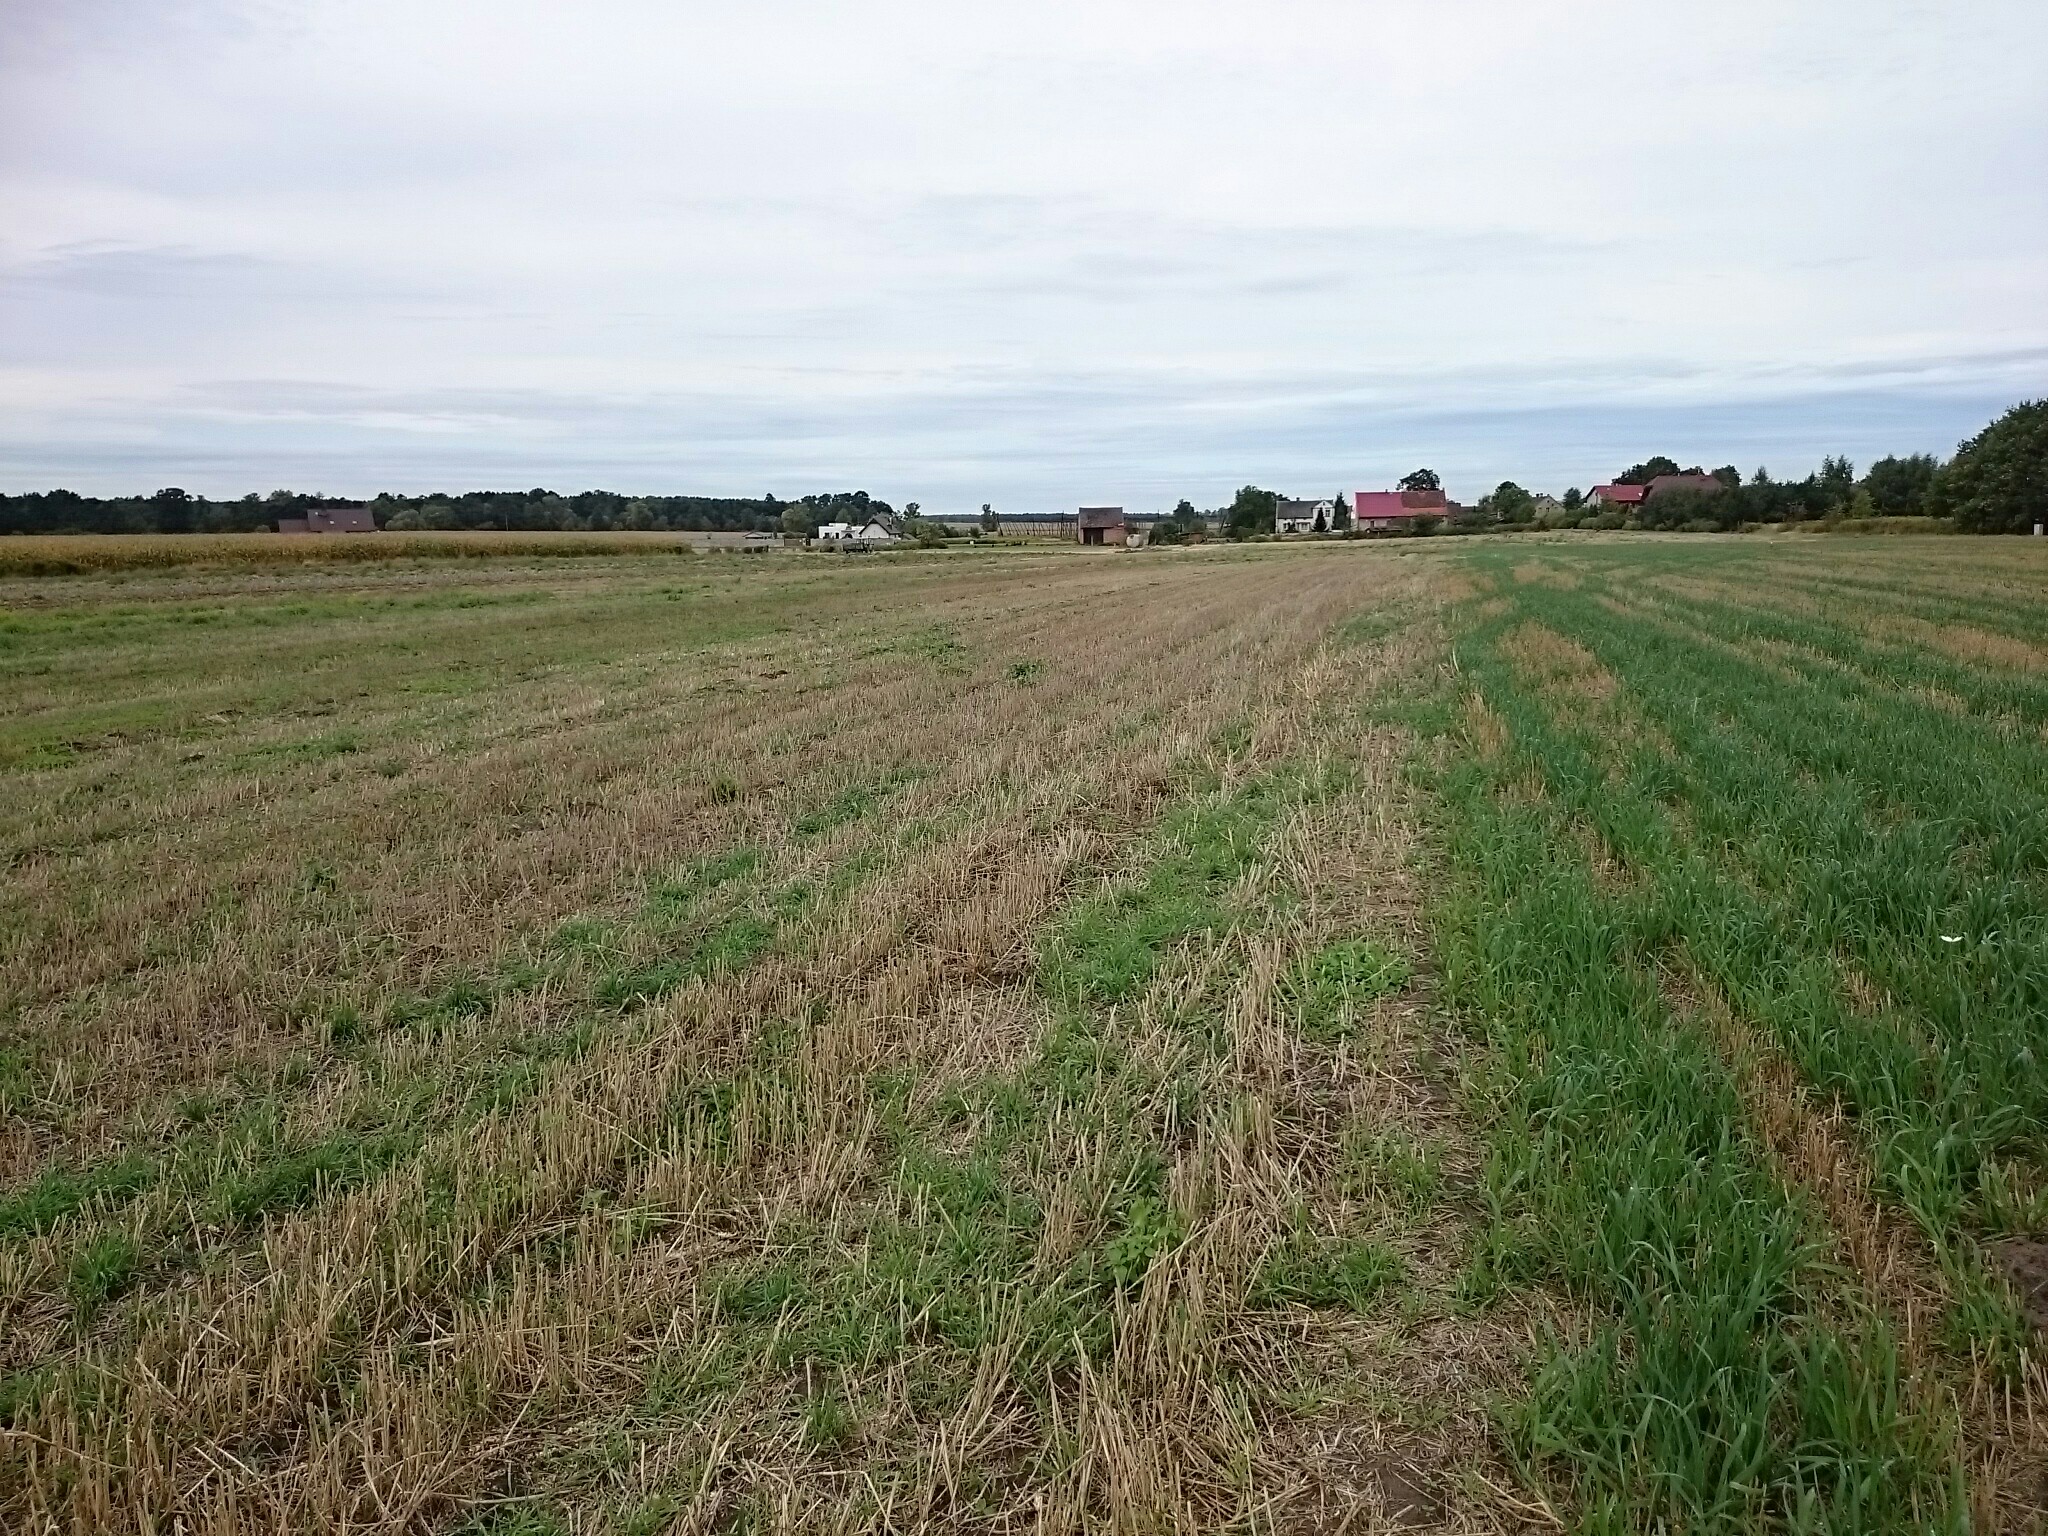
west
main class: Cropland
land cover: Rye
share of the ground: 50 - 75 %
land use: Agriculture (excluding fallow land and kitchen gardens)
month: September
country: PL
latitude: 51.1425
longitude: 17.2871
